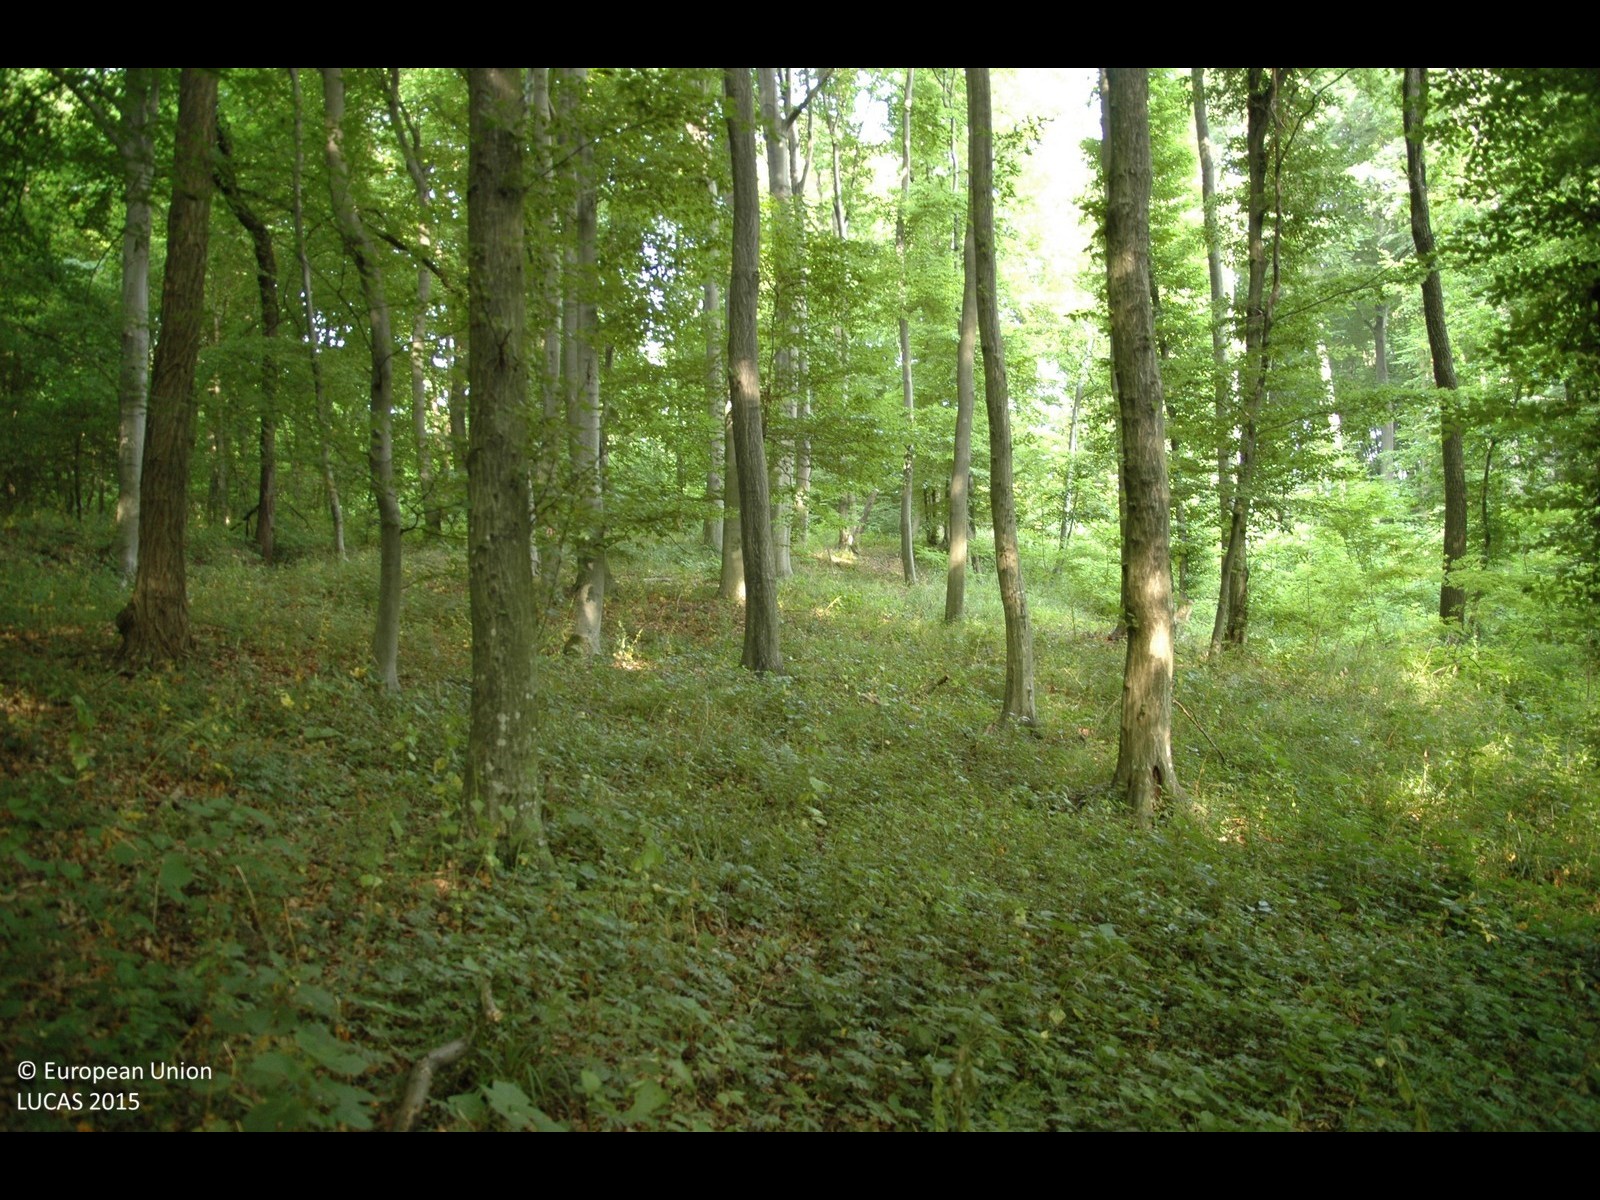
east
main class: Woodland
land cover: Broadleaved woodland
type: beech forest
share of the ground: > 75 %
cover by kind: broadleaved forest trees 100 %
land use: Forestry
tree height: > 5 m
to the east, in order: Broadleaved woodland; Tracks; Broadleaved woodland; Fences; Apple fruit; Fences; Grassland without tree/shrub cover; Fences; Grass margins; Paved roads, cycling and walking lanes; Broadleaved woodland
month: June
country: HR
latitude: 46.4879
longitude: 16.3450
